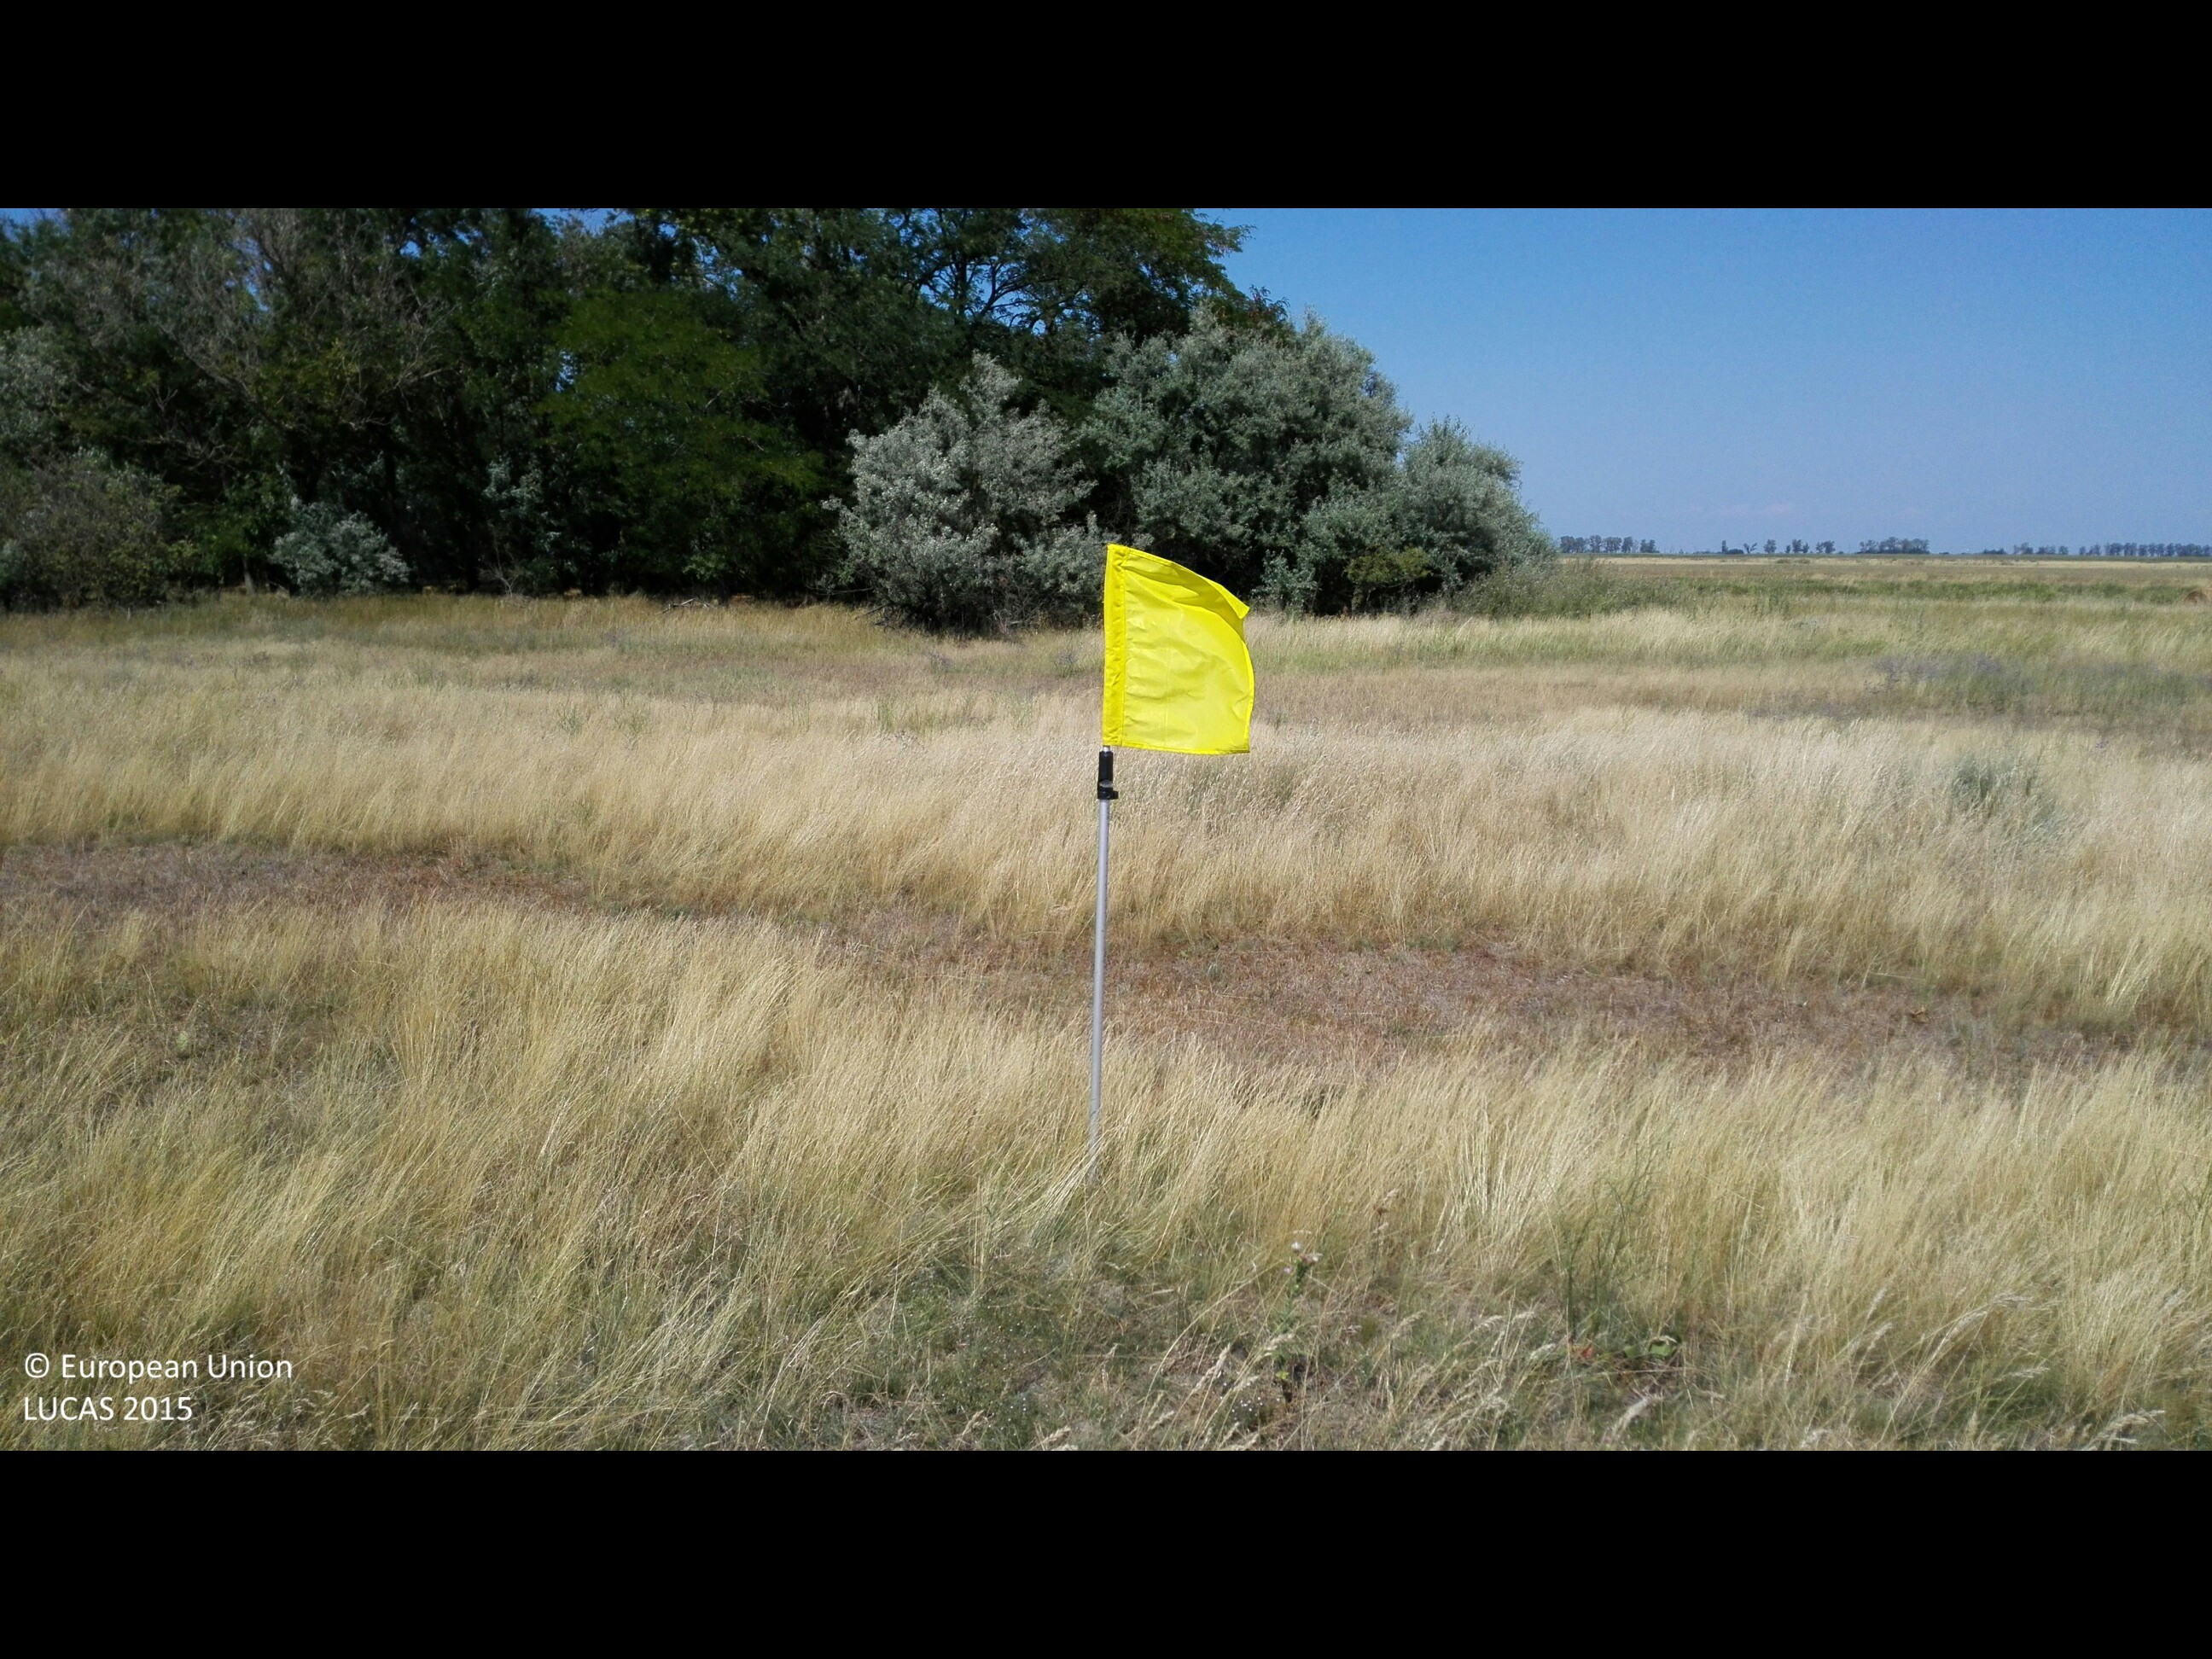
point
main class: Grassland
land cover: Grassland without tree/shrub cover
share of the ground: > 75 %
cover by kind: herbaceous plants 100 %
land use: Agriculture (excluding fallow land and kitchen gardens)
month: July
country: HU
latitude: 47.2605
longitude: 21.2852
